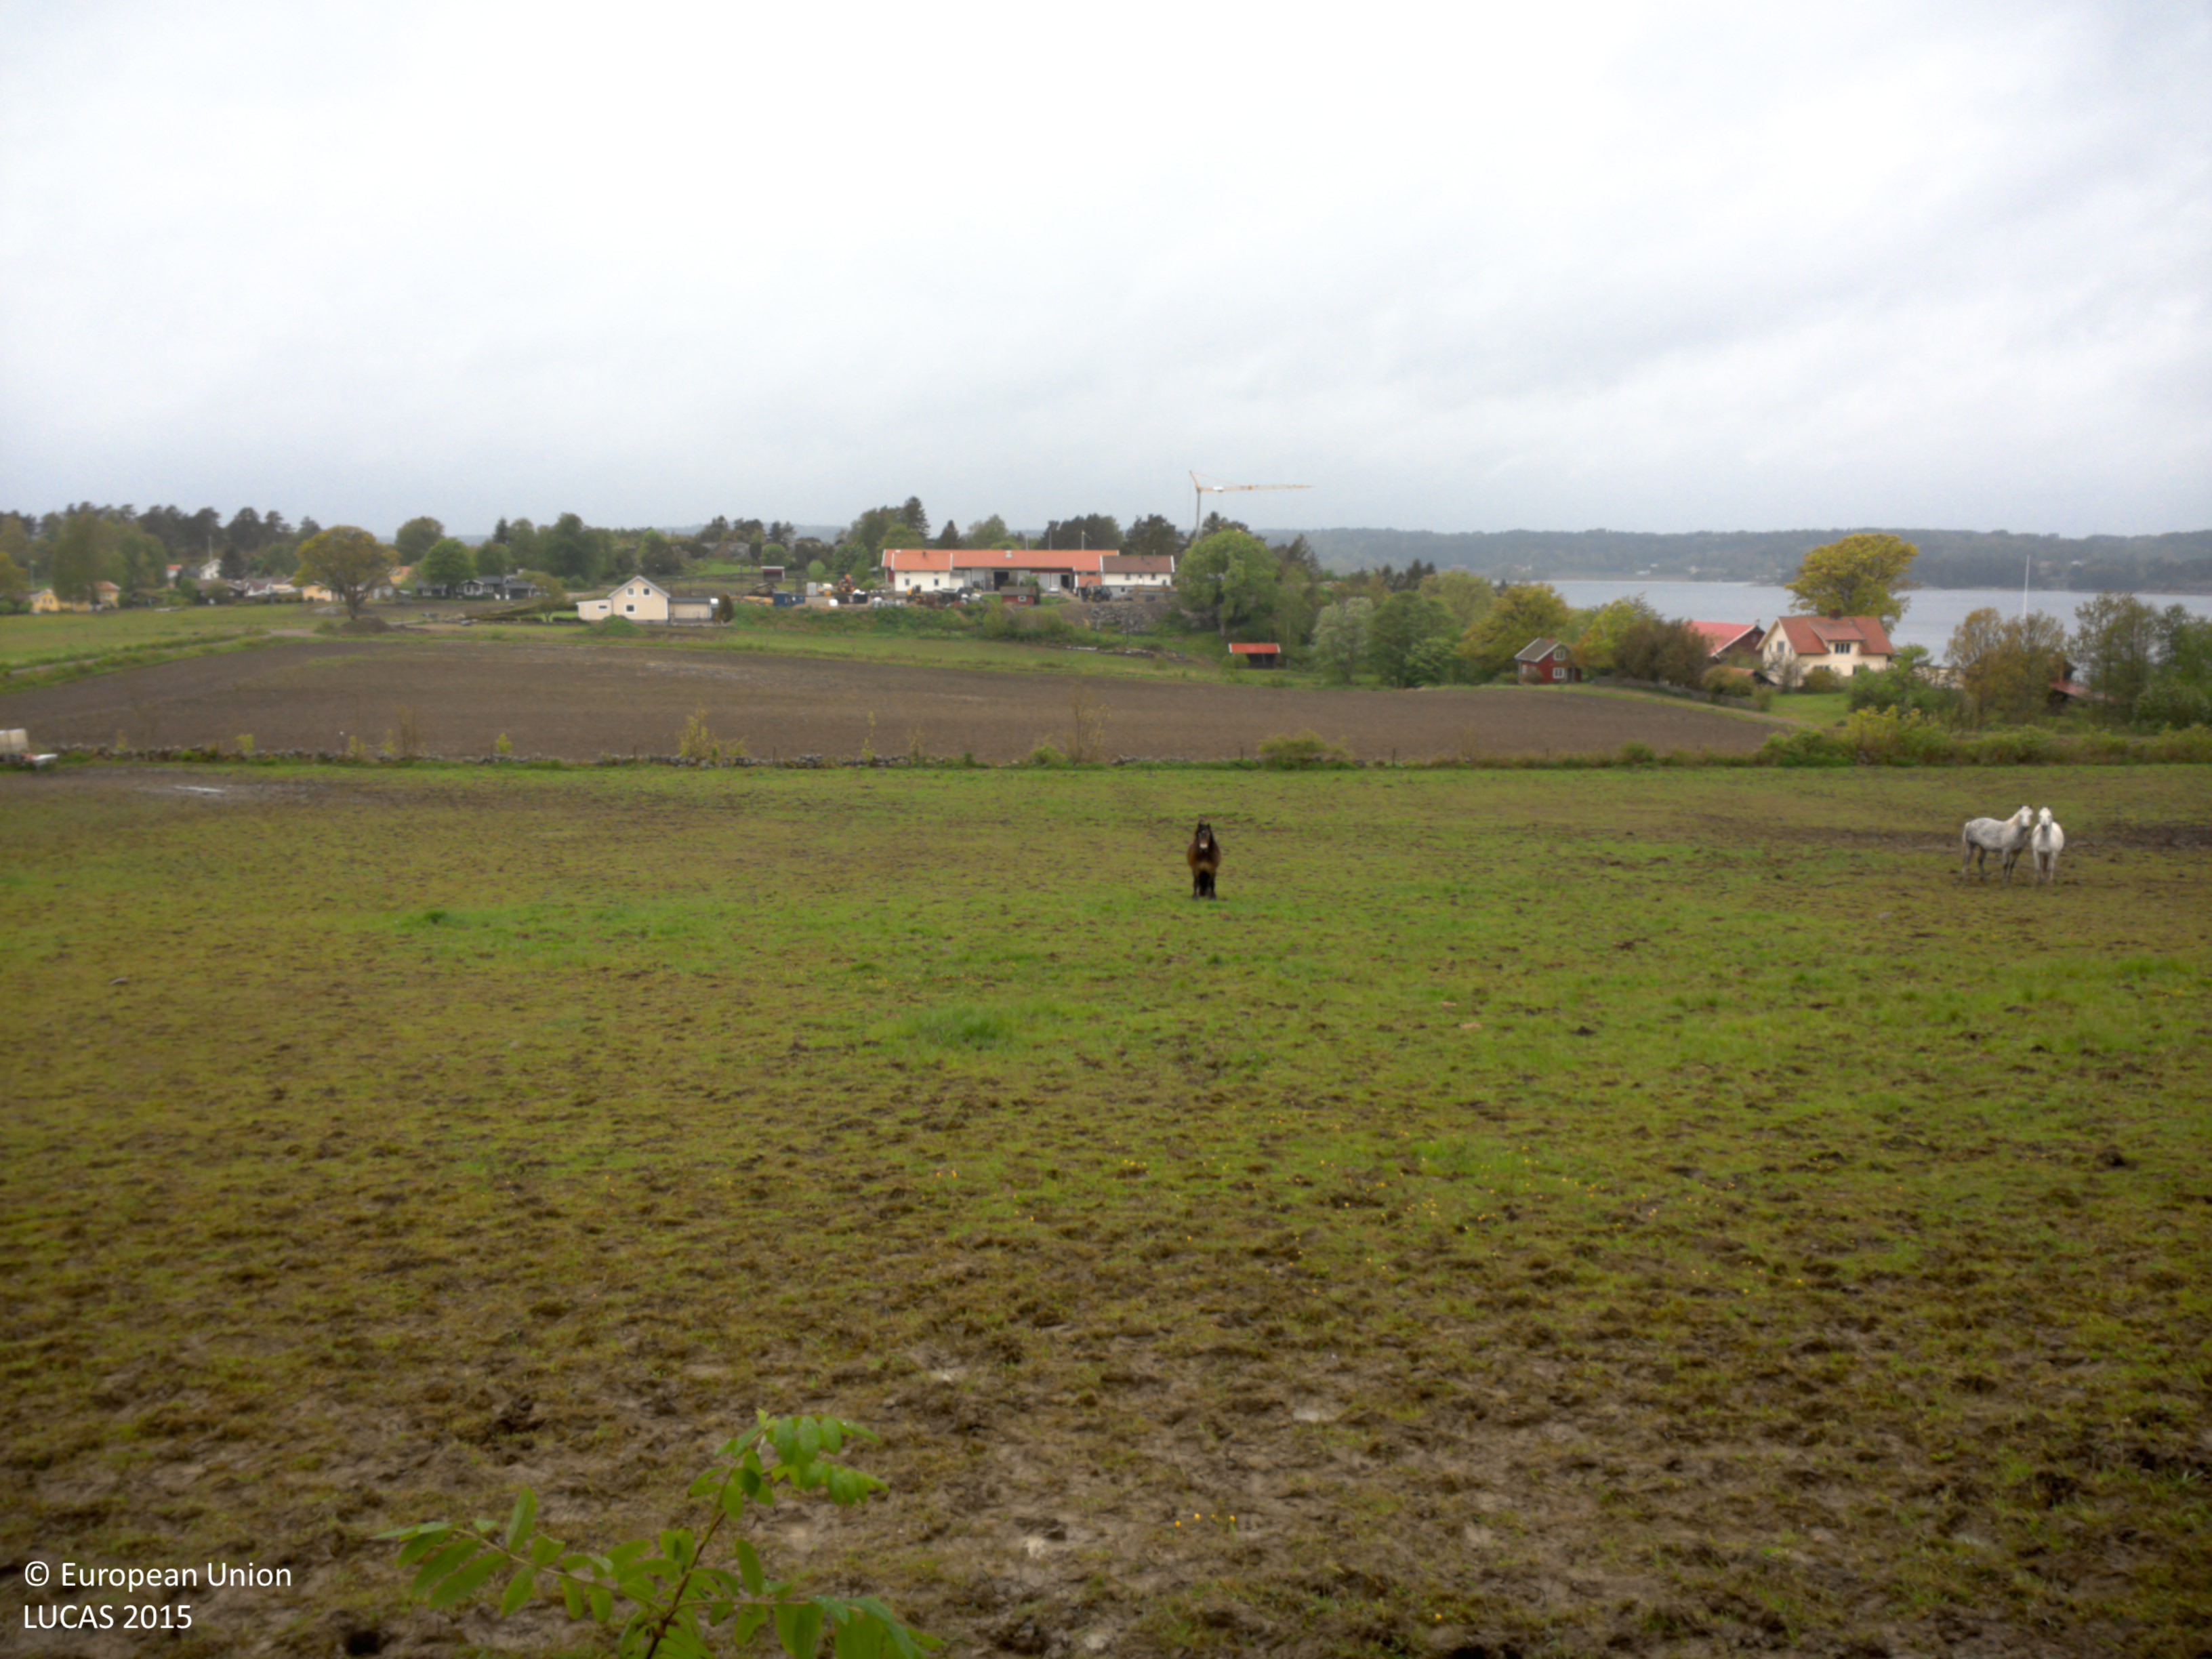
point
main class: Grassland
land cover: Grassland without tree/shrub cover
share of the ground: > 75 %
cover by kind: herbaceous plants 100 %
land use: Agriculture (excluding fallow land and kitchen gardens)
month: May
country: SE
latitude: 58.3361
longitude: 11.5852
